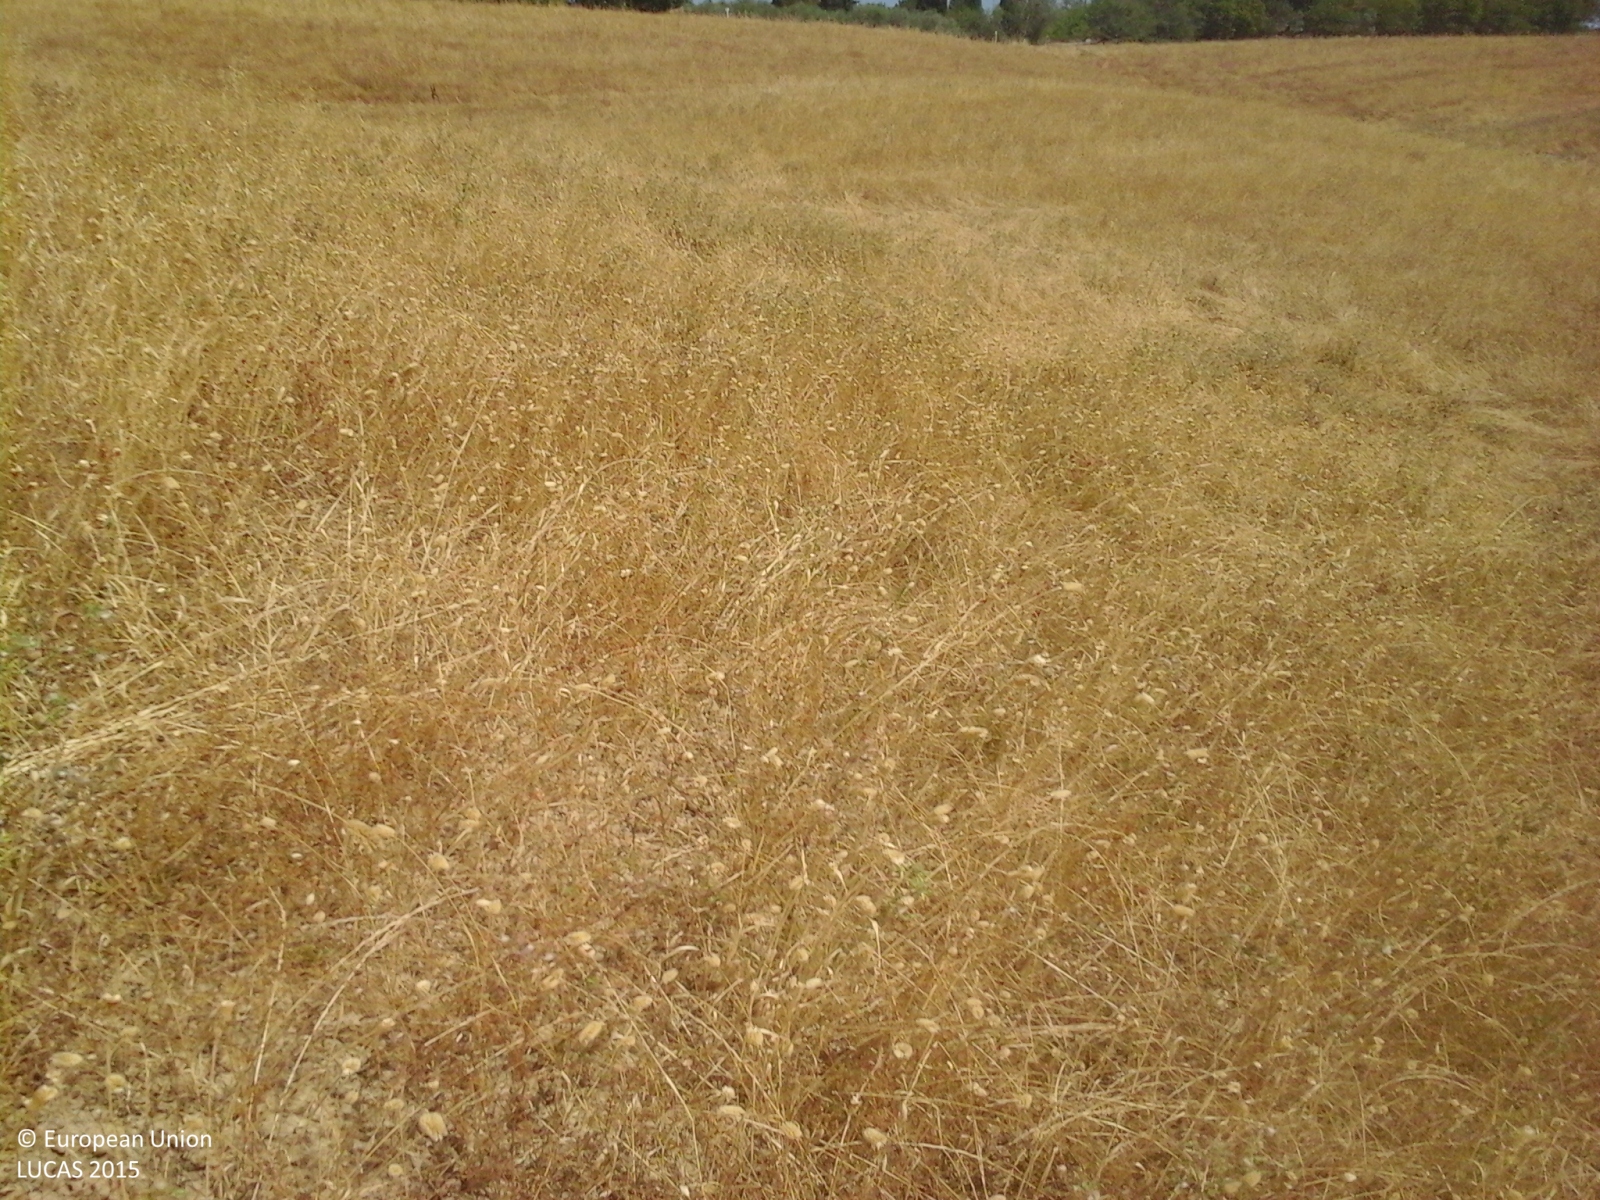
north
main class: Cropland
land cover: Temporary grasslands
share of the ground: > 75 %
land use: Agriculture (excluding fallow land and kitchen gardens)
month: July
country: IT
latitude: 43.1120
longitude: 11.5315
